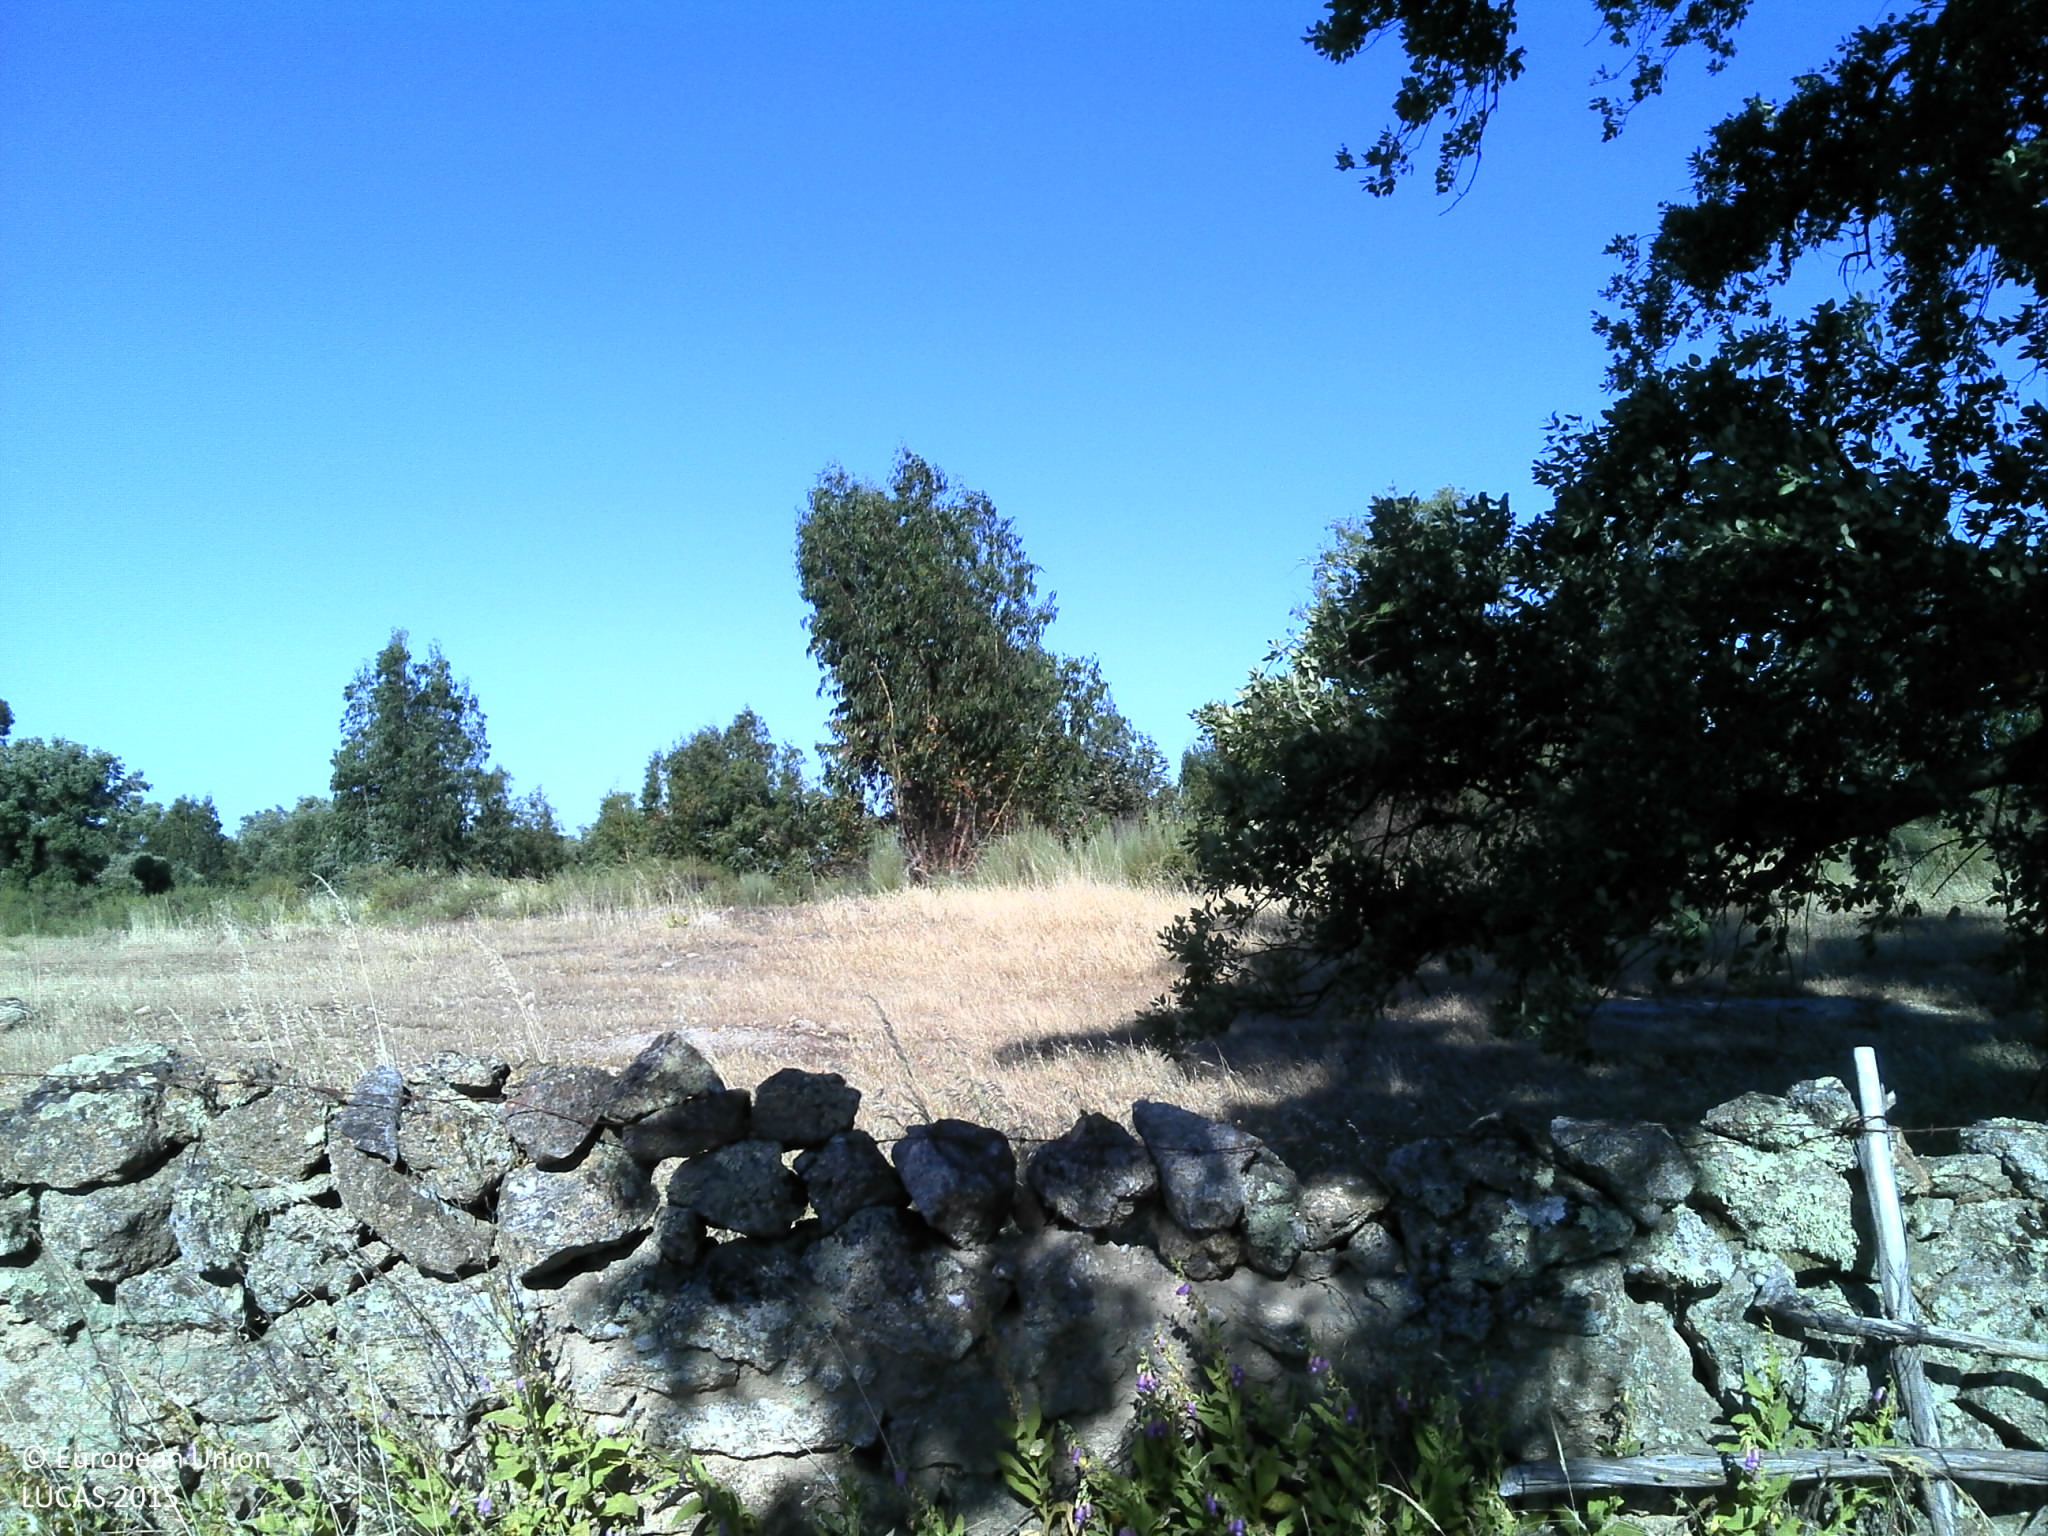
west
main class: Grassland
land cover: Grassland with sparse tree/shrub cover
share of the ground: 50 - 75 %
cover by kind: herbaceous plants 75 %, unconsolidated bare surface 20 %, broadleaved forest trees 5 %
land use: Agriculture (excluding fallow land and kitchen gardens)
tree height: > 5 m
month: May
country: PT
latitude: 39.3977
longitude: -7.6167
